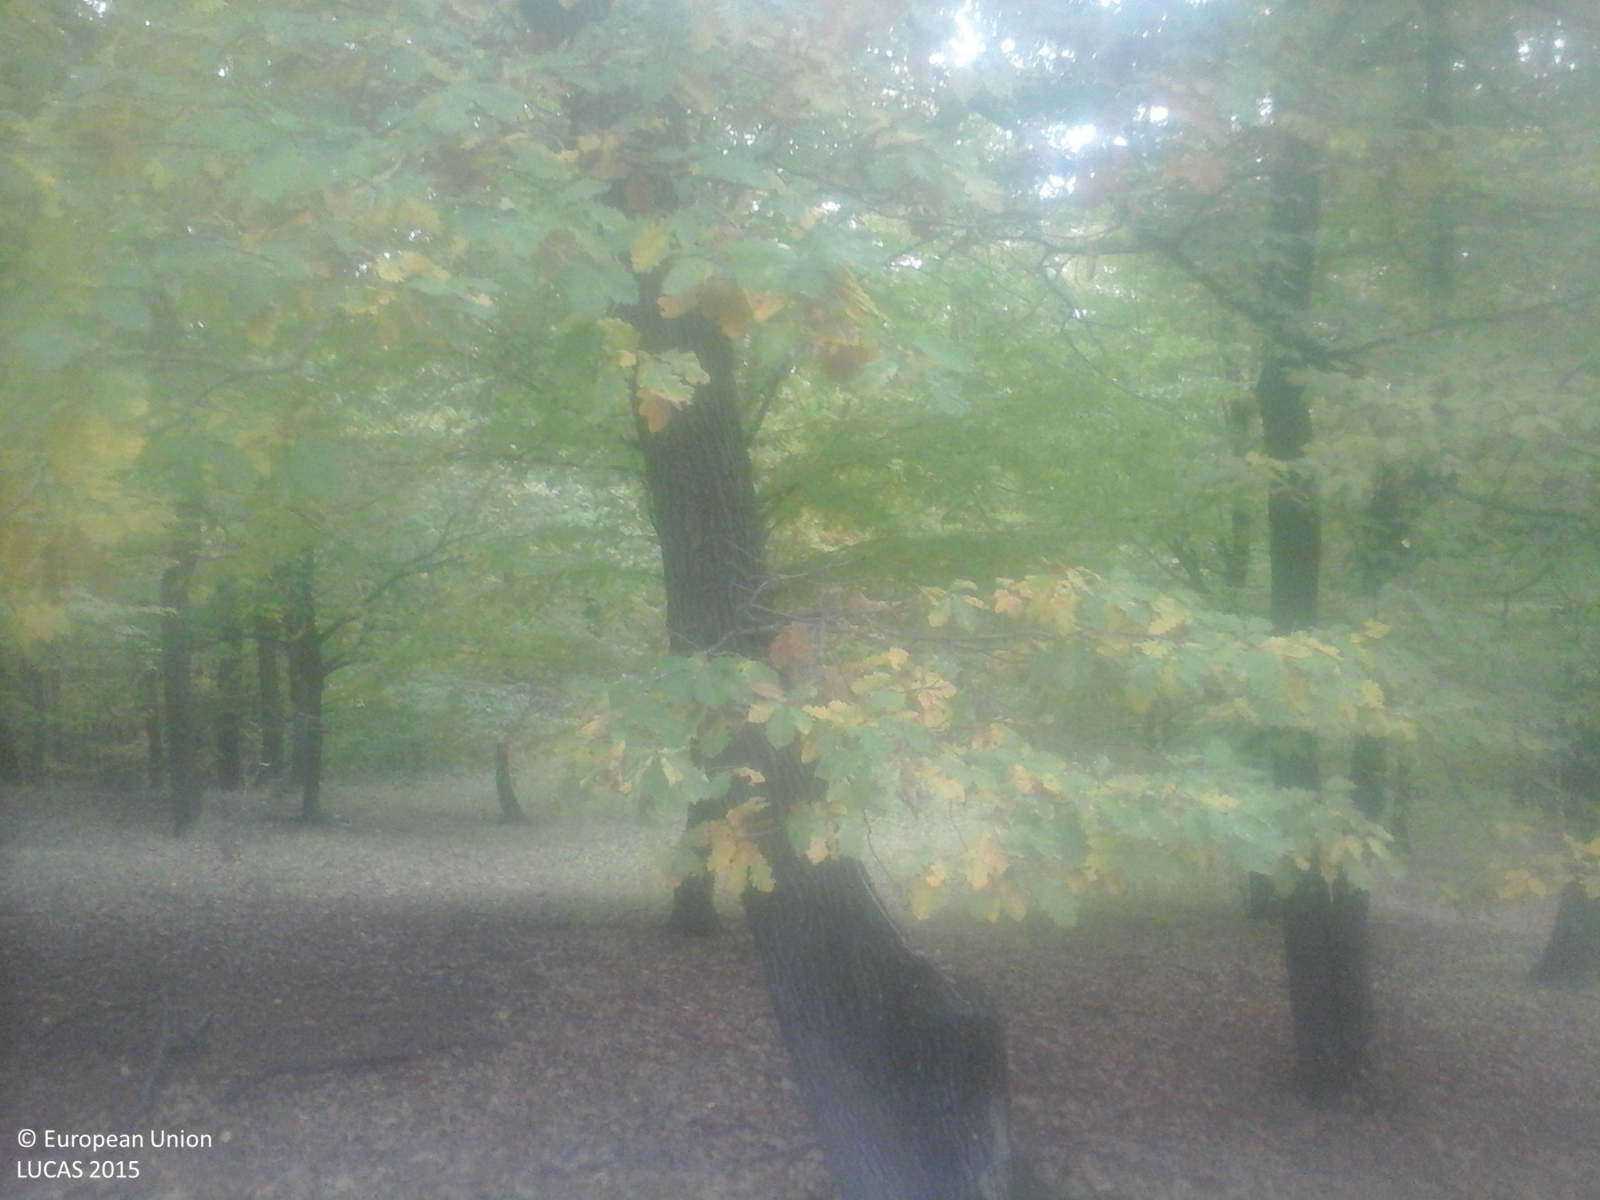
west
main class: Woodland
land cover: Broadleaved woodland
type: acidophilous oak and oak-birch forest
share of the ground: > 75 %
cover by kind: broadleaved forest trees 100 %
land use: Forestry
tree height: > 5 m
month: October
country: RO
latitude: 45.0319
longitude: 25.7270
